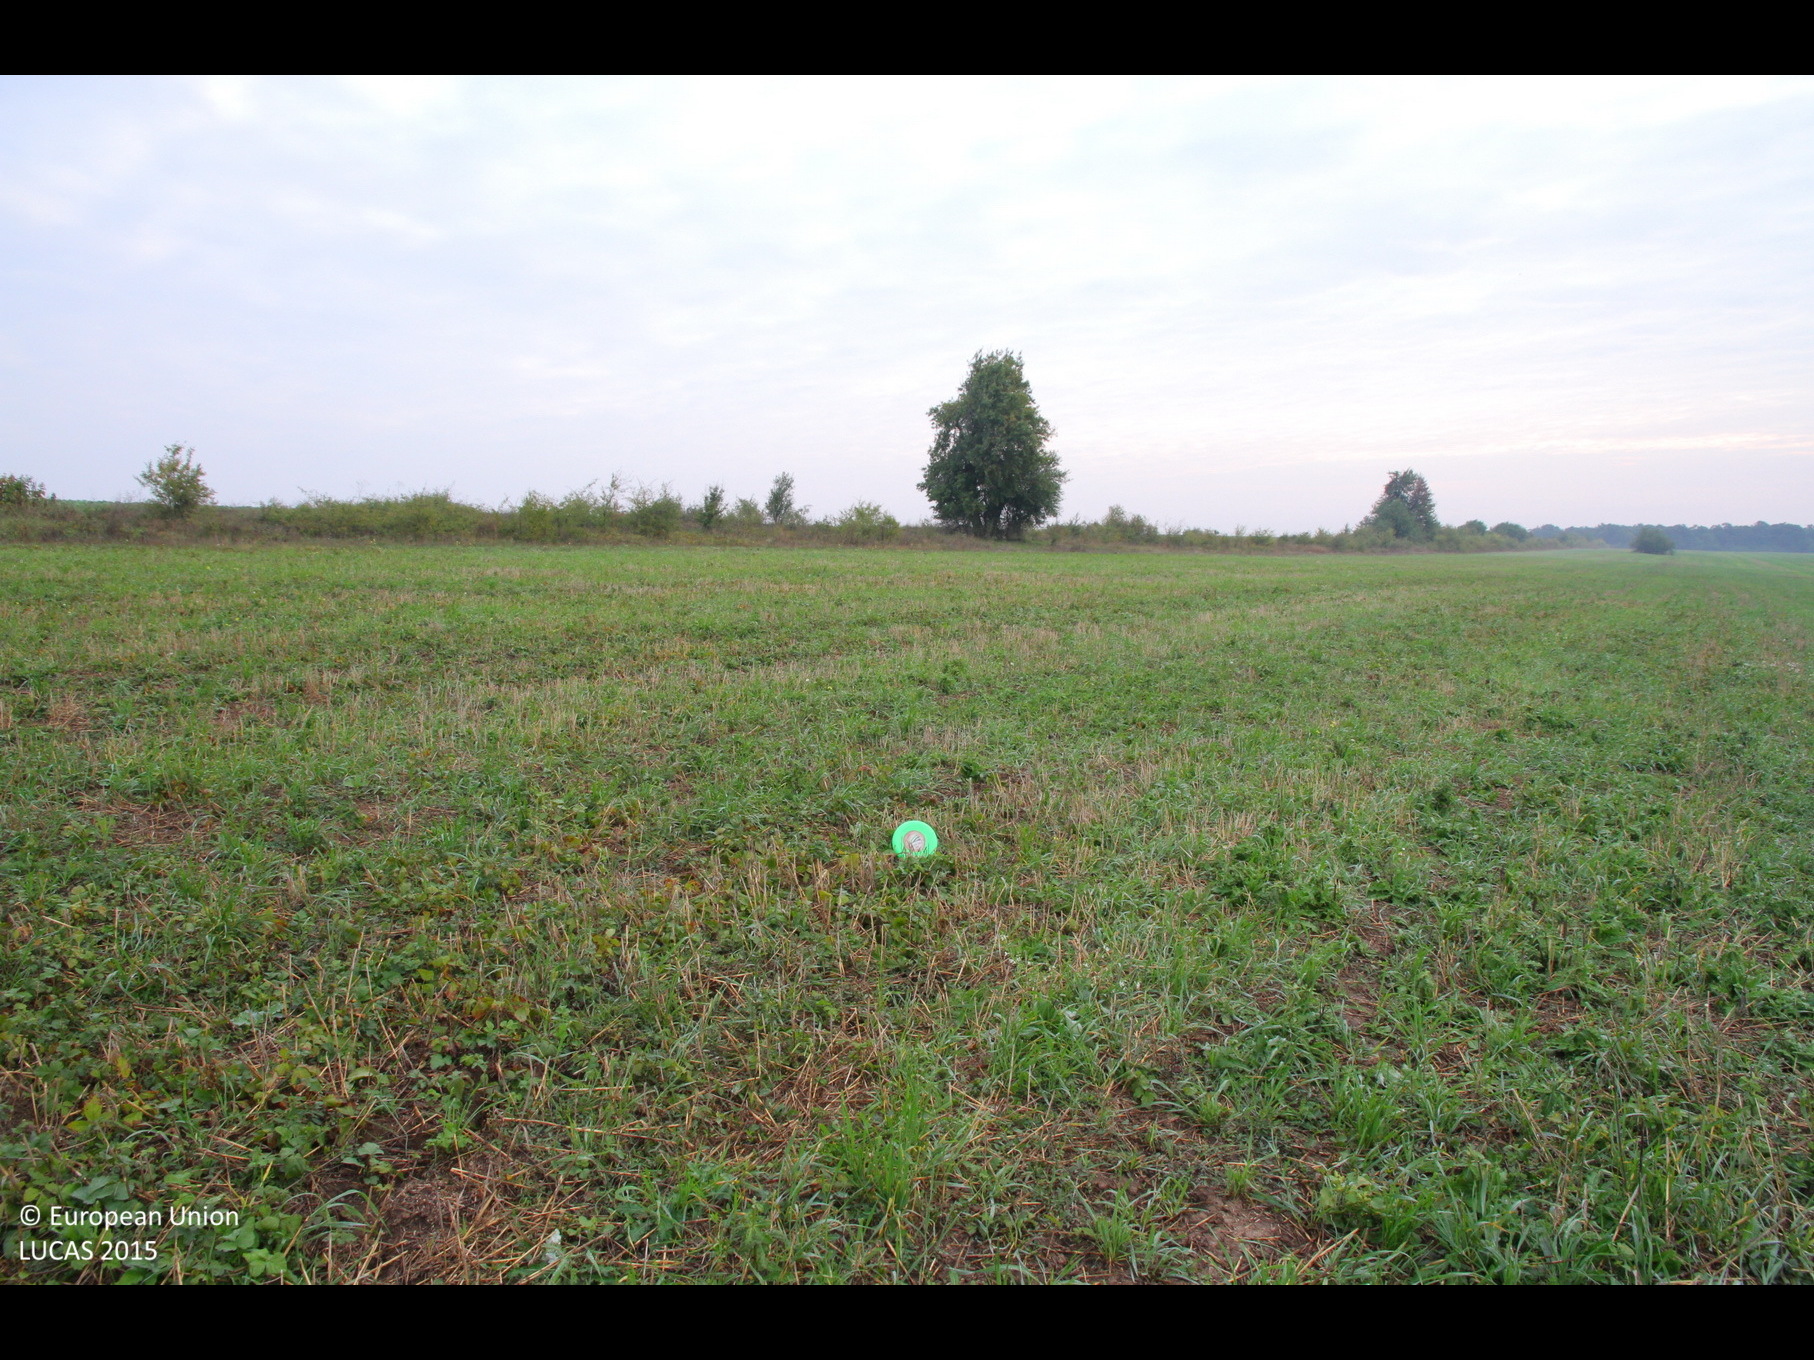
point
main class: Cropland
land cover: Common wheat
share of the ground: < 10 %
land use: Agriculture (excluding fallow land and kitchen gardens)
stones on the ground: < 10 %
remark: Harvested field
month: October
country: BG
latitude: 43.4881
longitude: 26.9954
